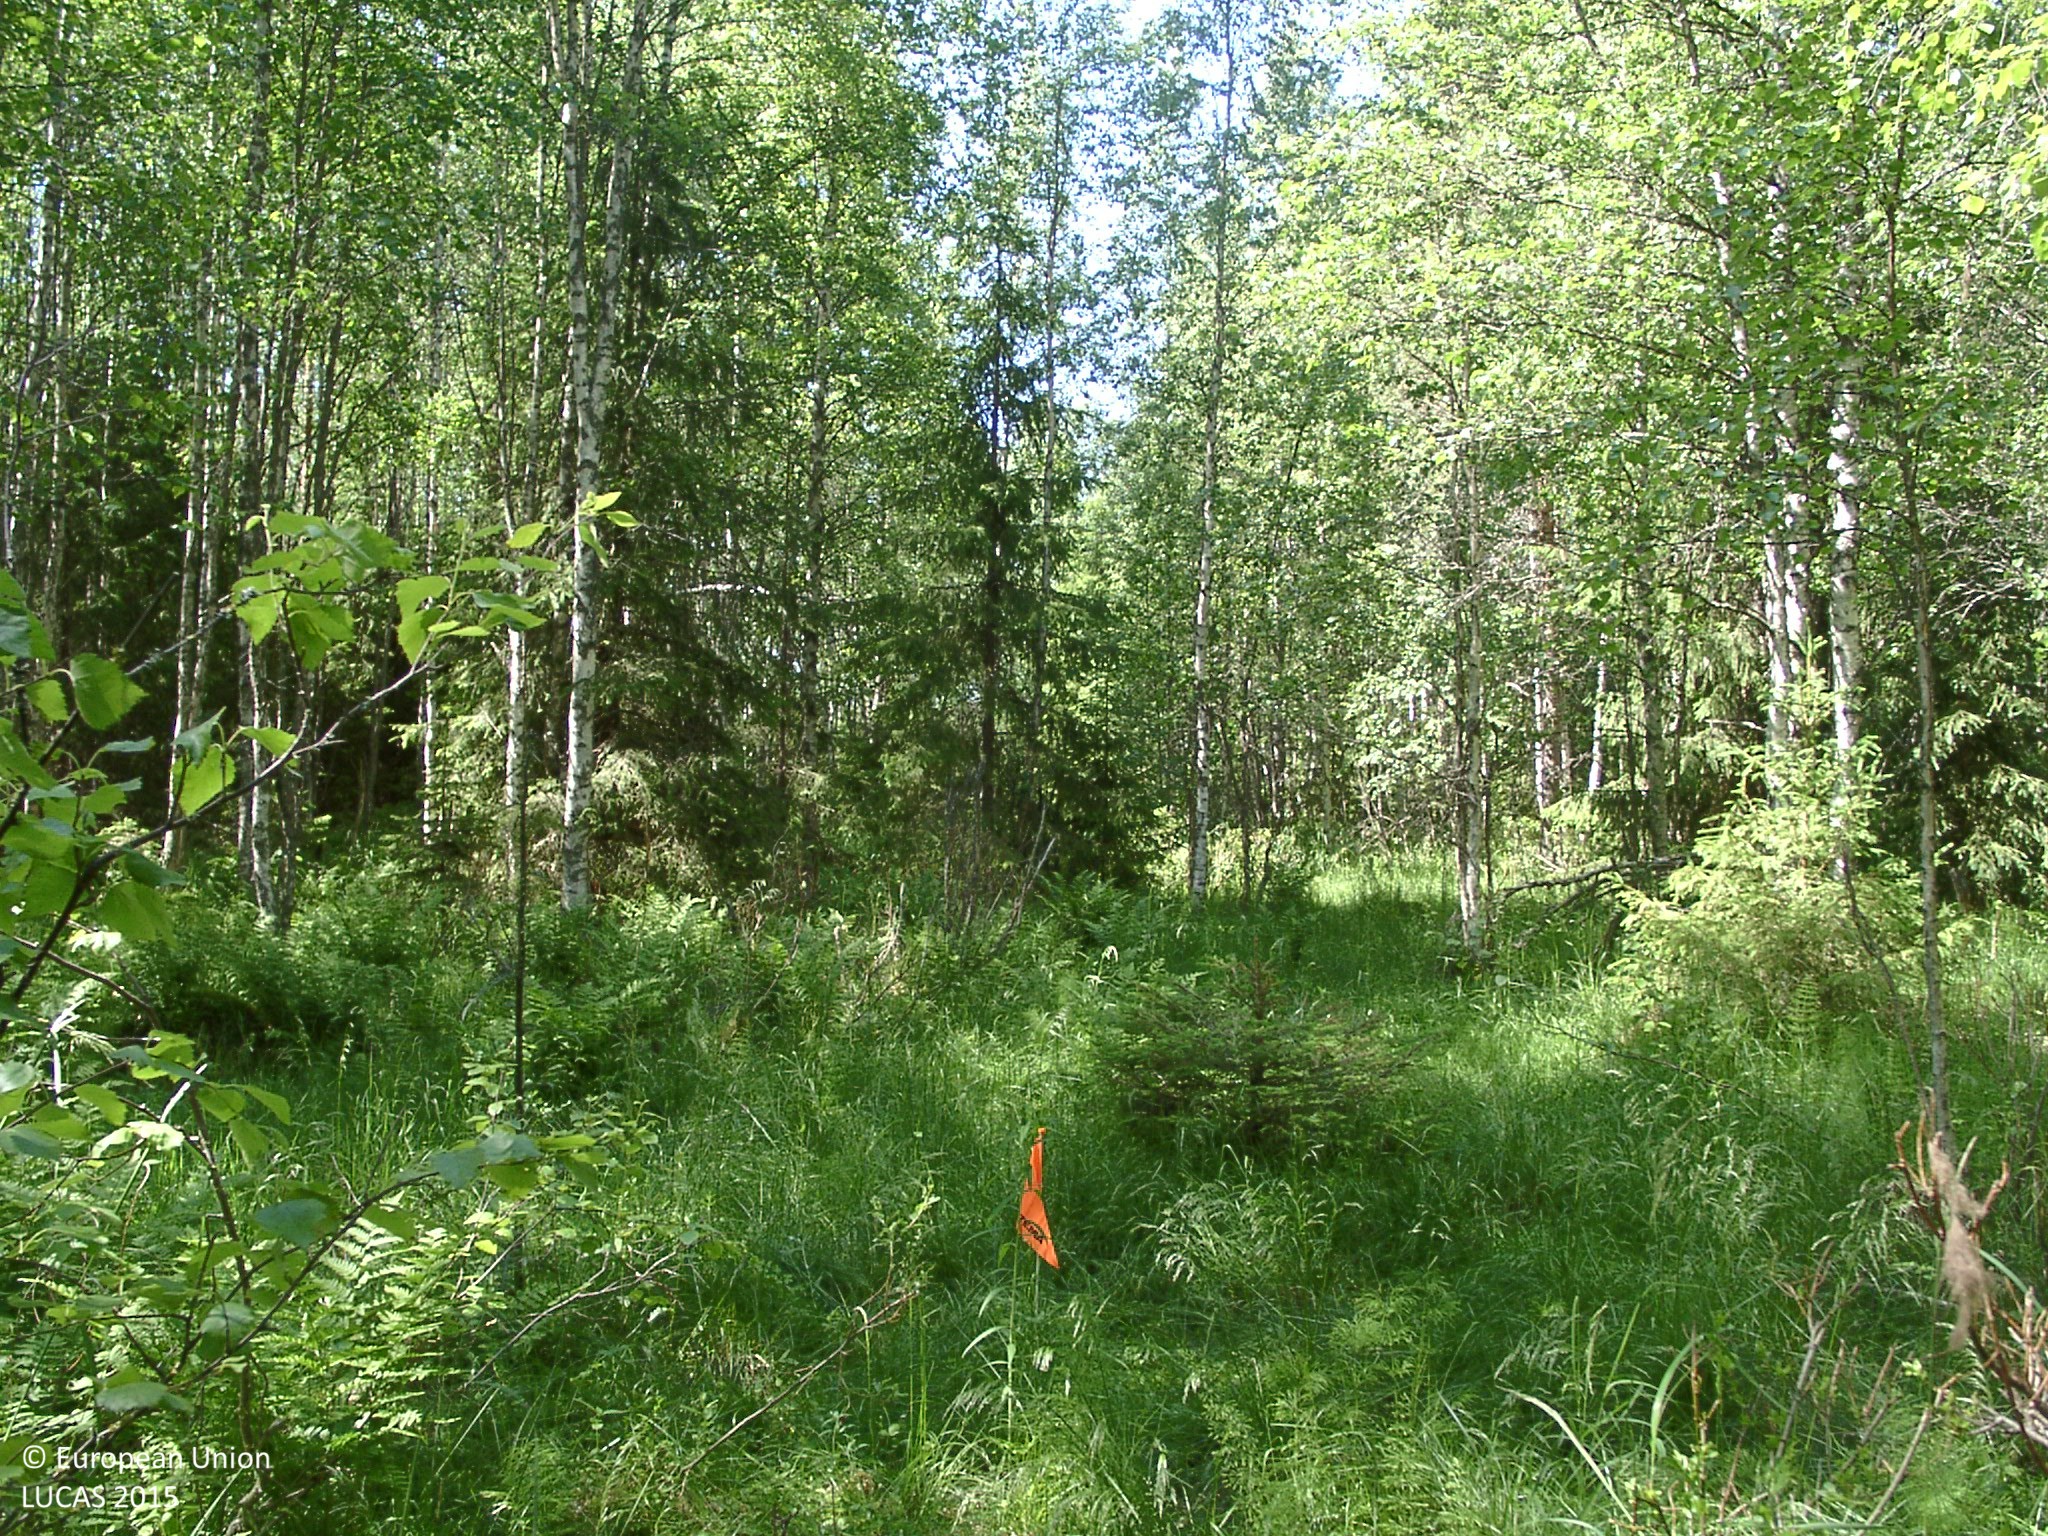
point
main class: Woodland
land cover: Spruce dominated mixed woodland
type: non-riverine alder, birch or aspen forest
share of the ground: 25 - 50 %
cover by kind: herbaceous plants 60 %, broadleaved forest trees 30 %, coniferous forest trees 10 %
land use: Forestry
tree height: > 5 m
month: July
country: FI
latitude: 62.0549
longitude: 25.2012
